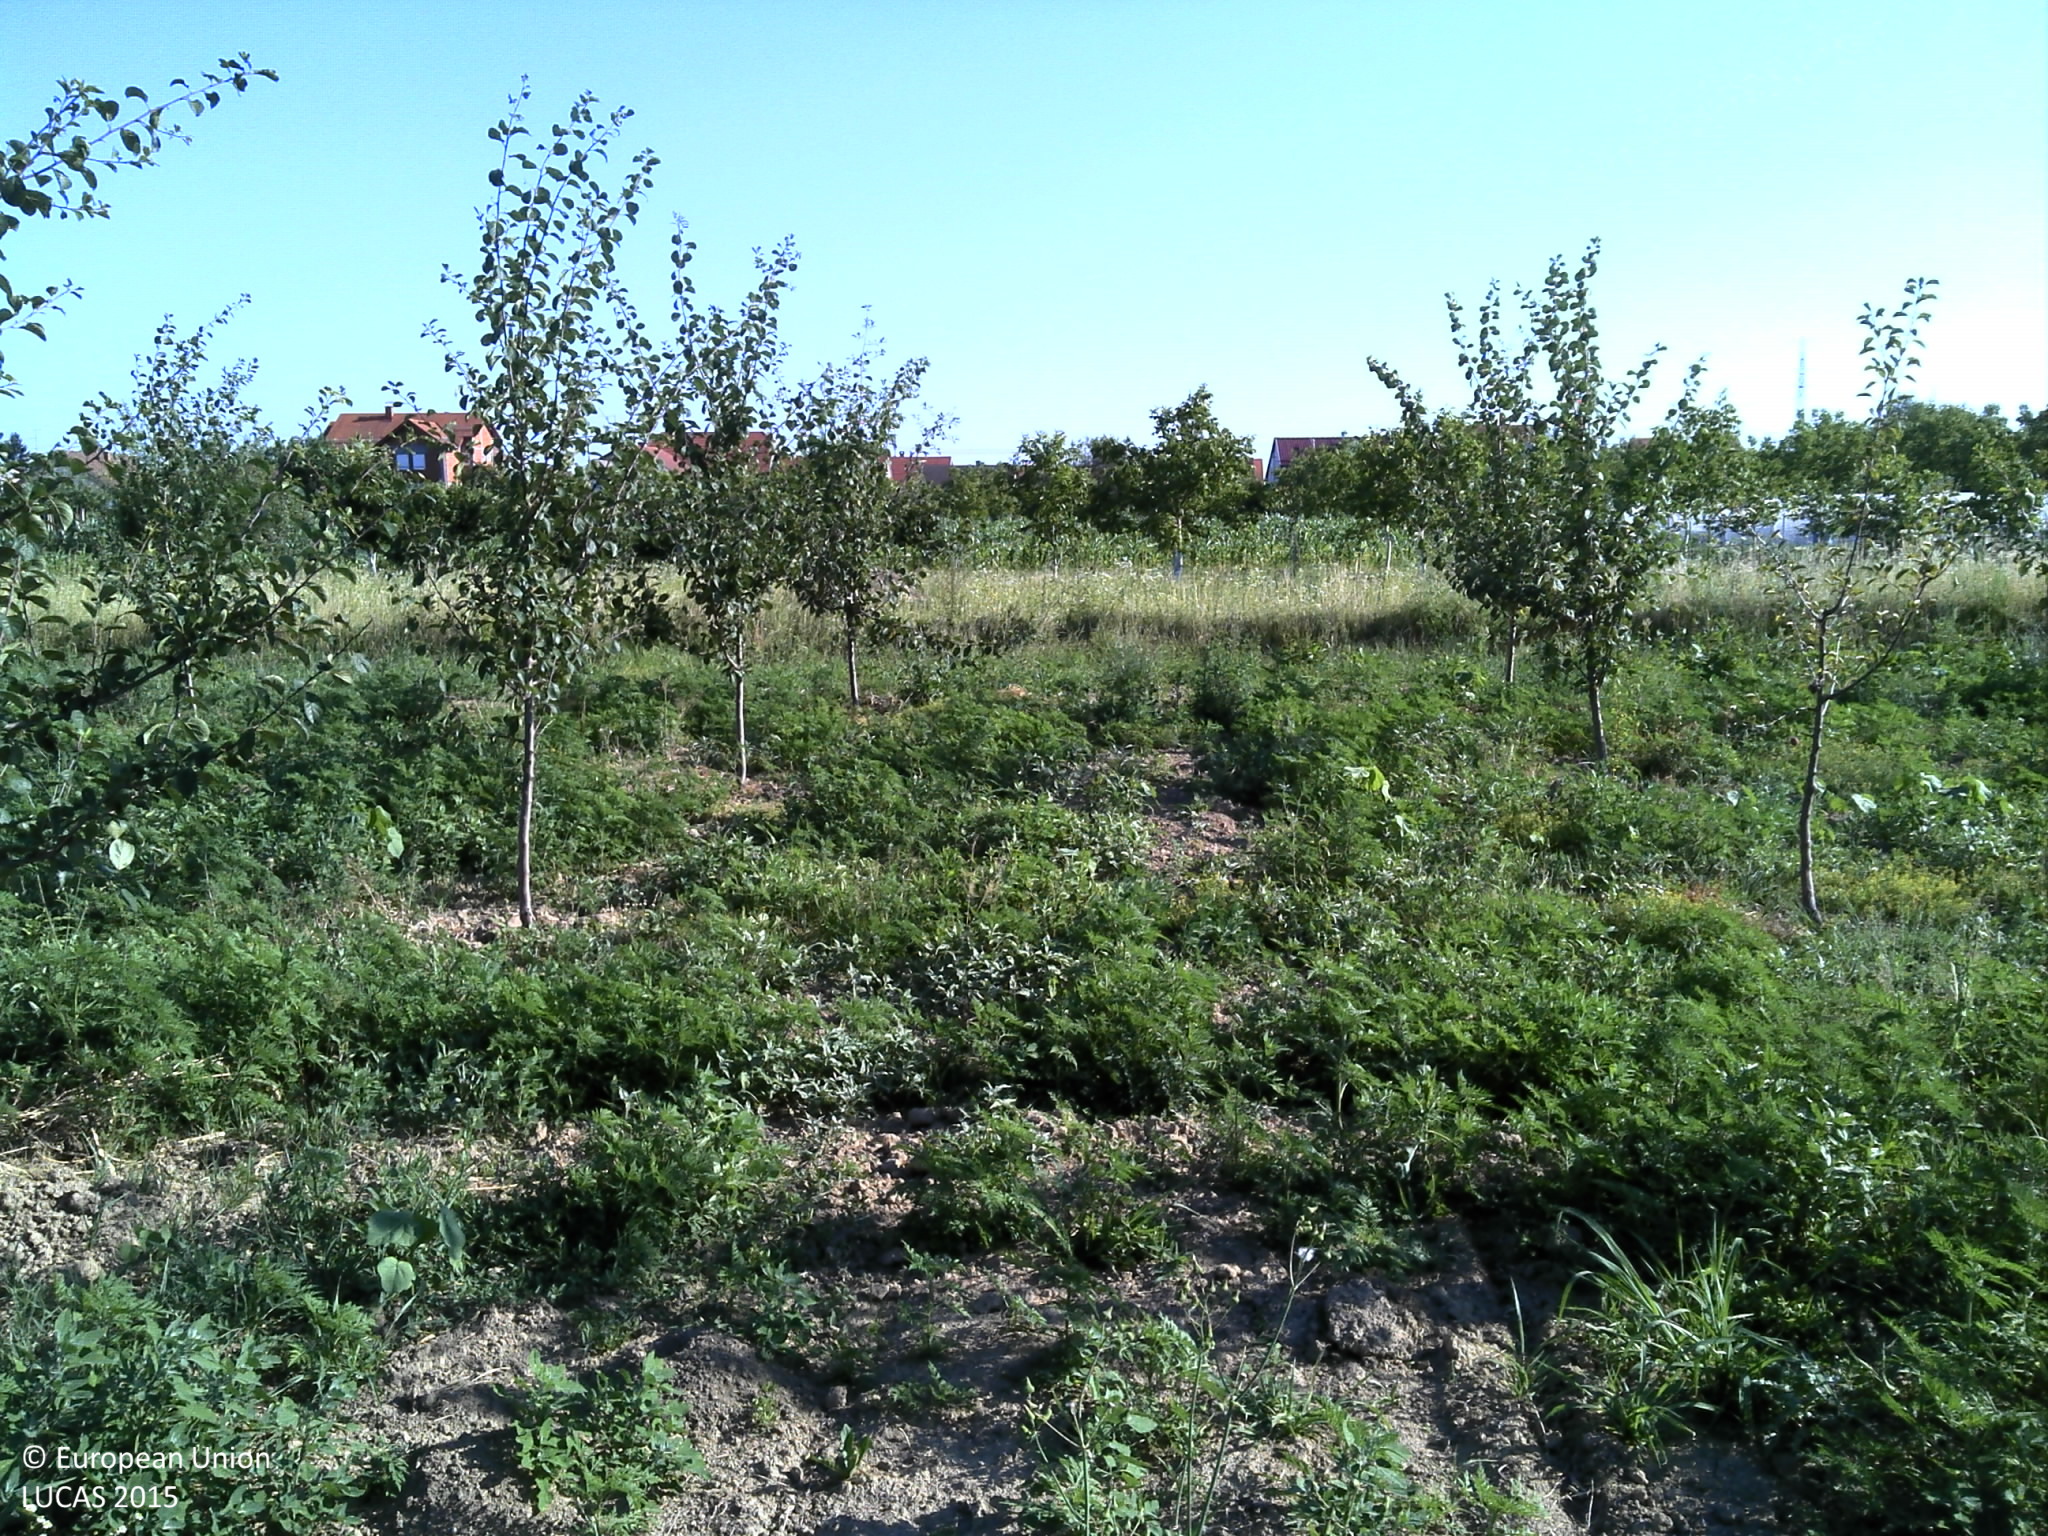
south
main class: Cropland
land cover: Other fruit trees and berries
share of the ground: 10 - 25 %
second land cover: Spontaneously vegetated surfaces
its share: 25 - 50 %
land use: Agriculture (excluding fallow land and kitchen gardens)
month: July
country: HR
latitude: 45.2953
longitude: 18.4082
